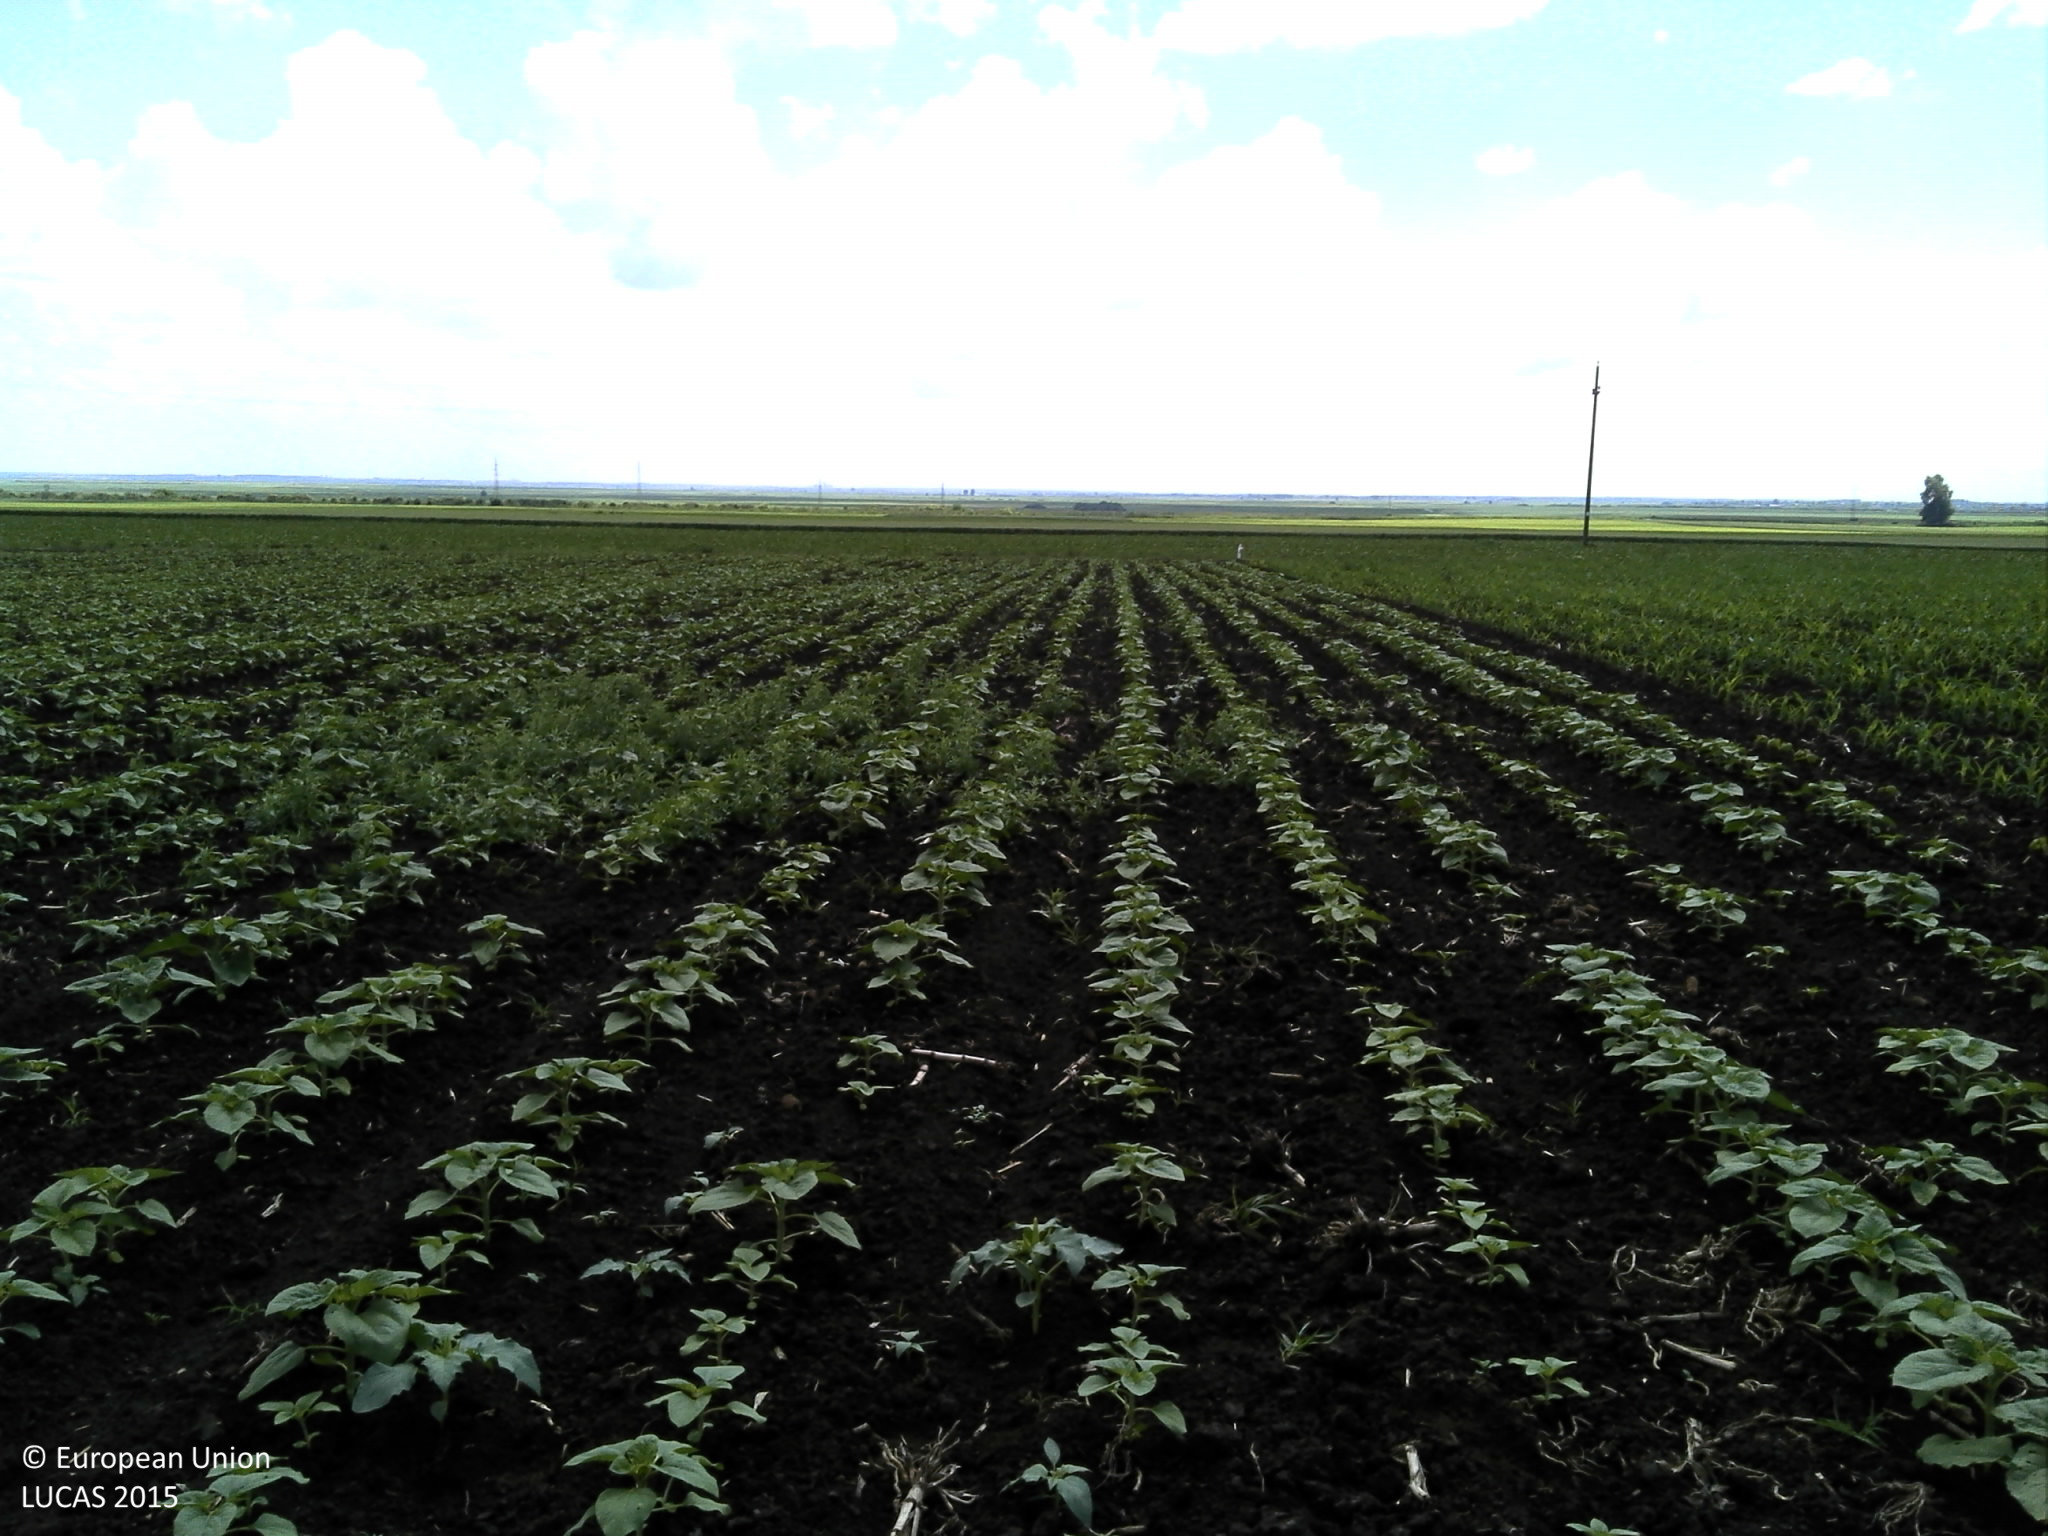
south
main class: Cropland
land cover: Sunflower
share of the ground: 10 - 25 %
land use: Agriculture (excluding fallow land and kitchen gardens)
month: May
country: HR
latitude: 45.5060
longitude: 18.9299
